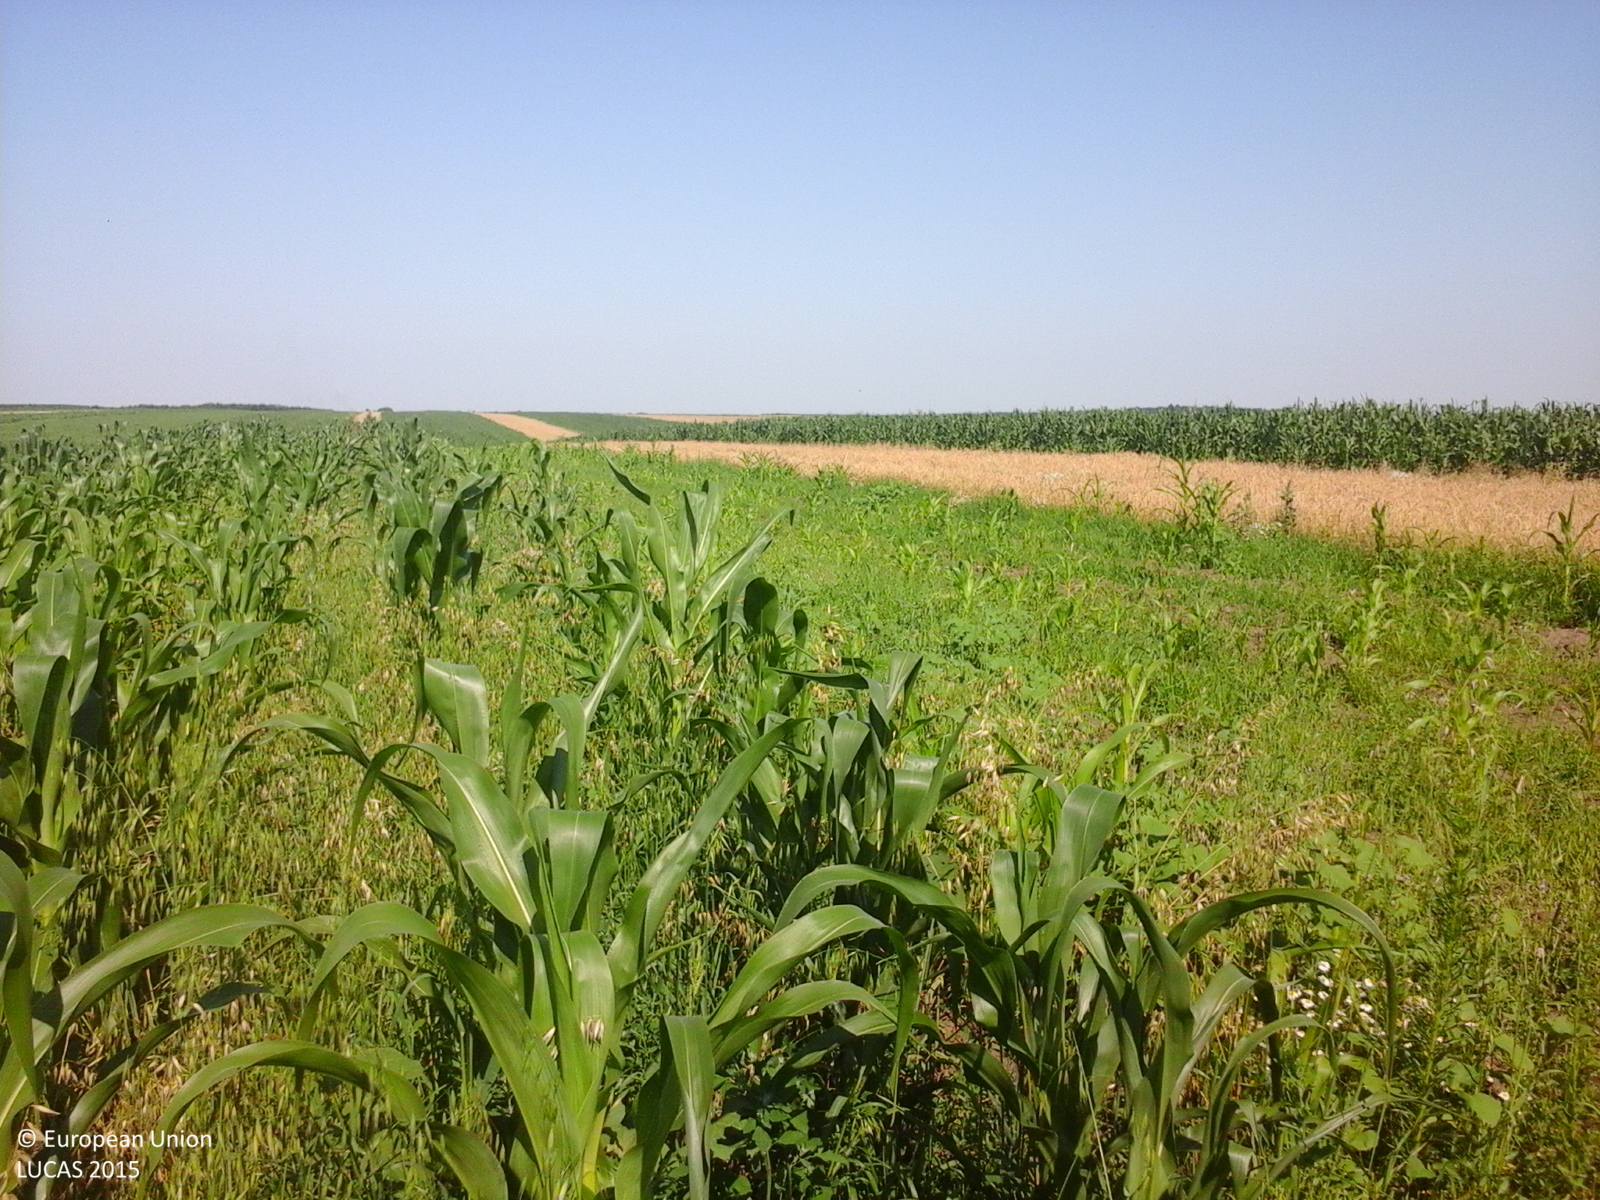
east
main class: Cropland
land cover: Maize
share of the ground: 50 - 75 %
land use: Agriculture (excluding fallow land and kitchen gardens)
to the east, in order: Maize; Grass margins; Maize; Common wheat; Maize; Common wheat; Oats; Spontaneously vegetated surfaces
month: July
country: RO
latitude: 44.5365
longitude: 24.6090
